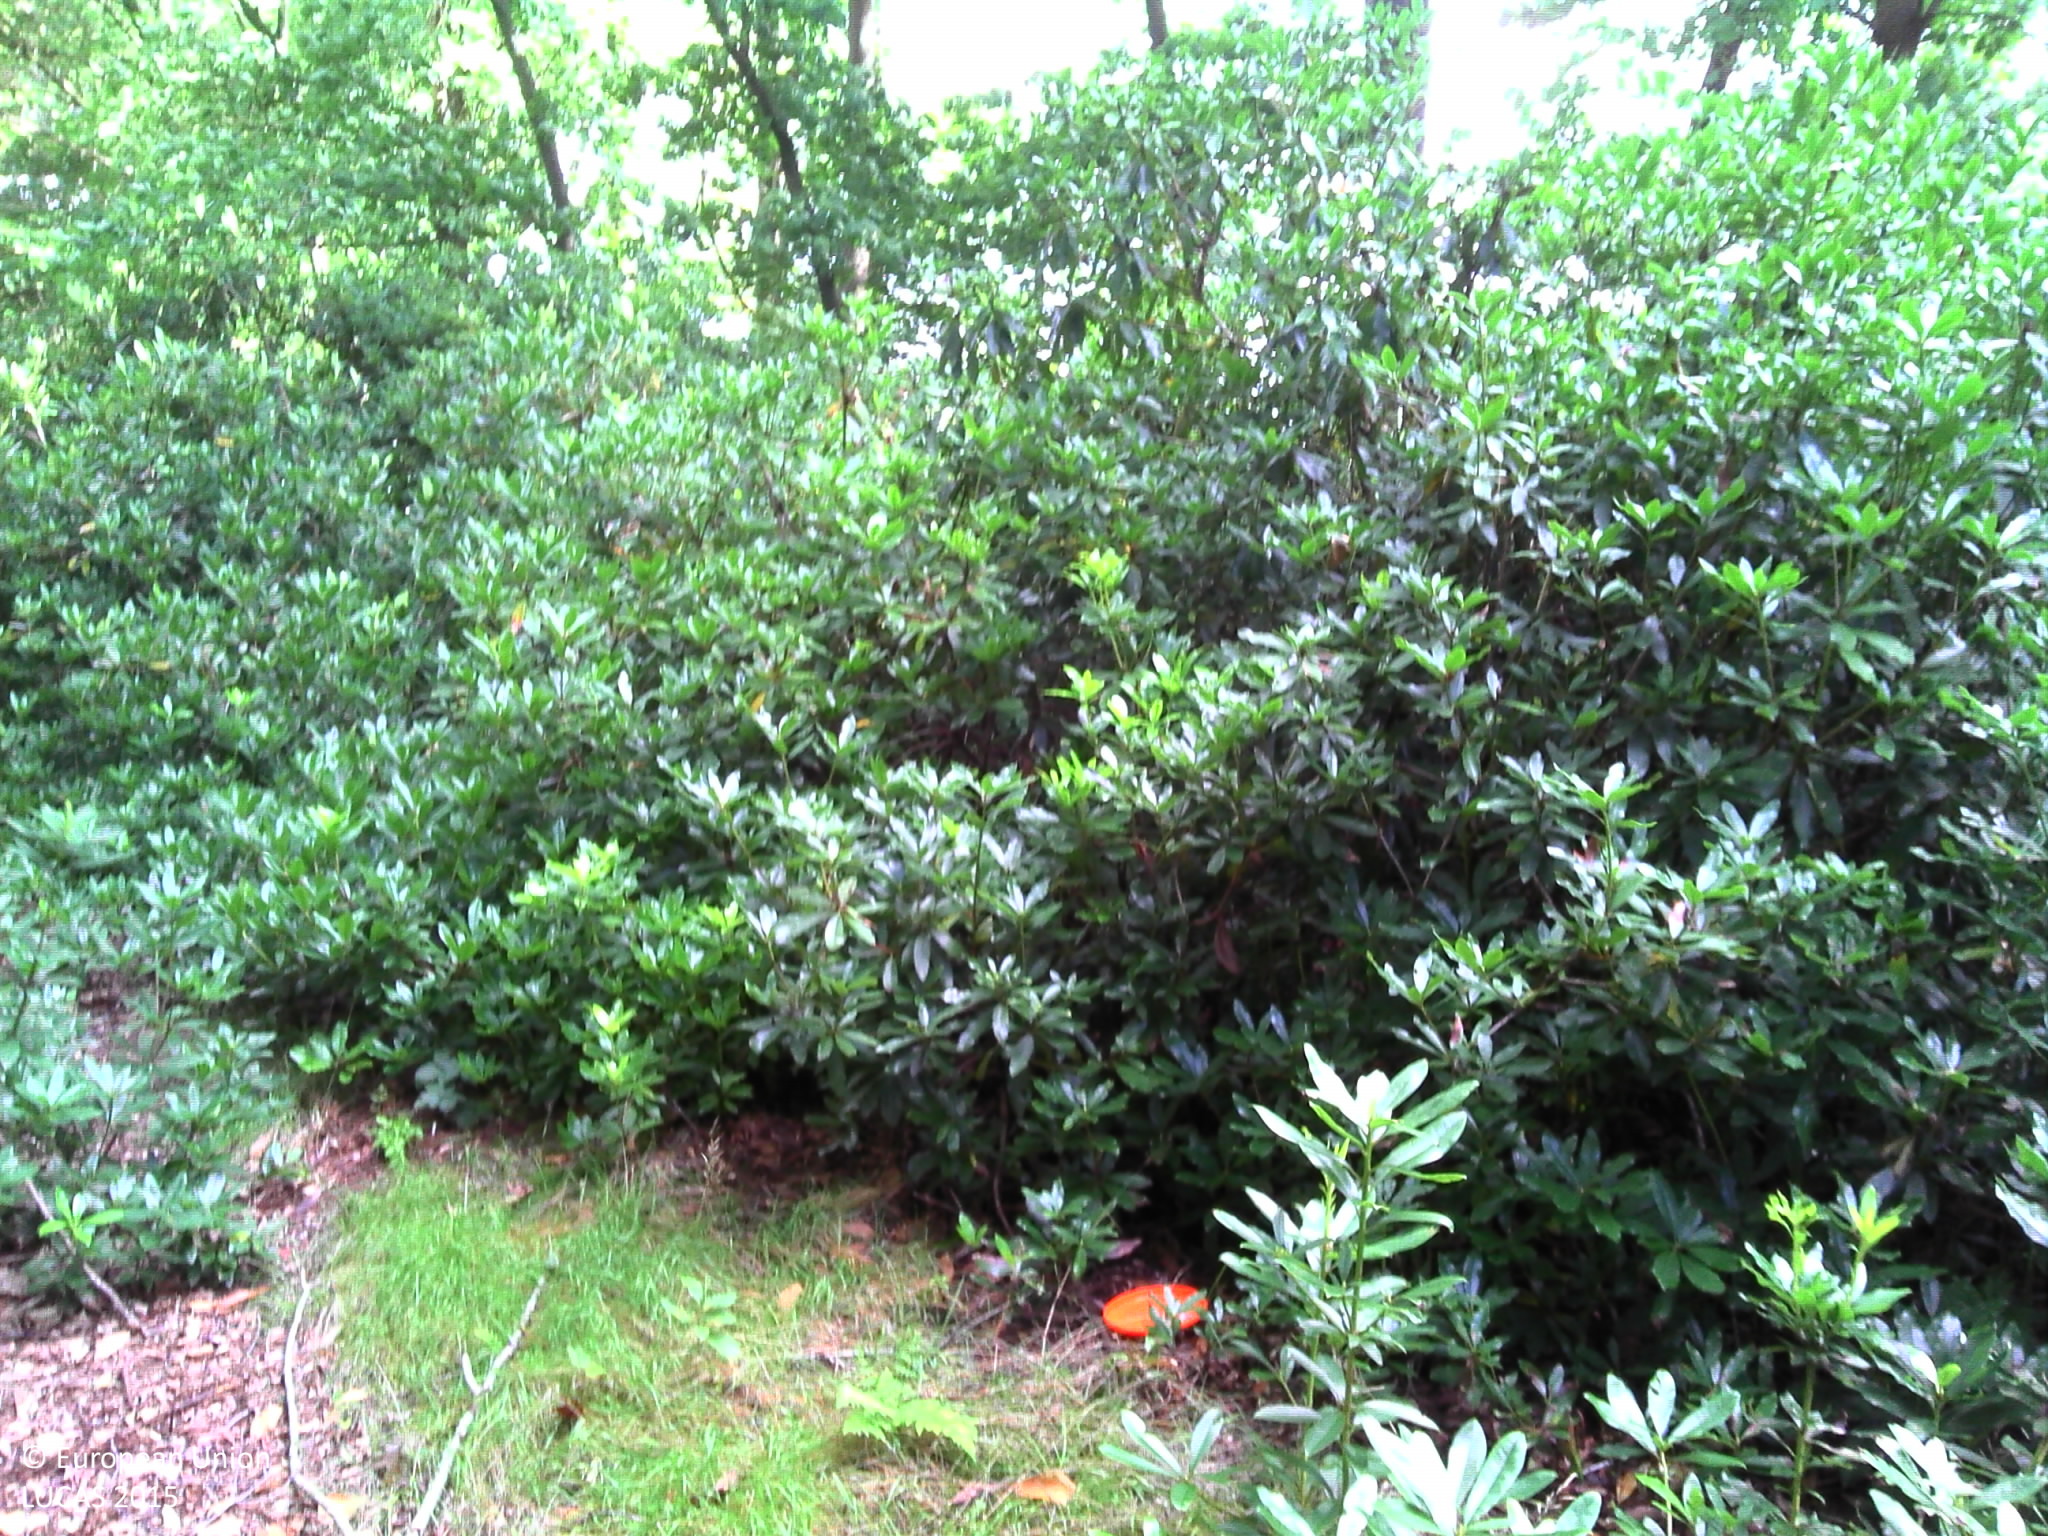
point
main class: Woodland
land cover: Broadleaved woodland
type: acidophilous oak and oak-birch forest
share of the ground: > 75 %
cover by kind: broadleaved forest trees 70 %, shrubs 20 %, herbaceous plants 10 %
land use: Forestry
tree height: > 5 m
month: September
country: BE
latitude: 51.4041
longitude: 4.5189
